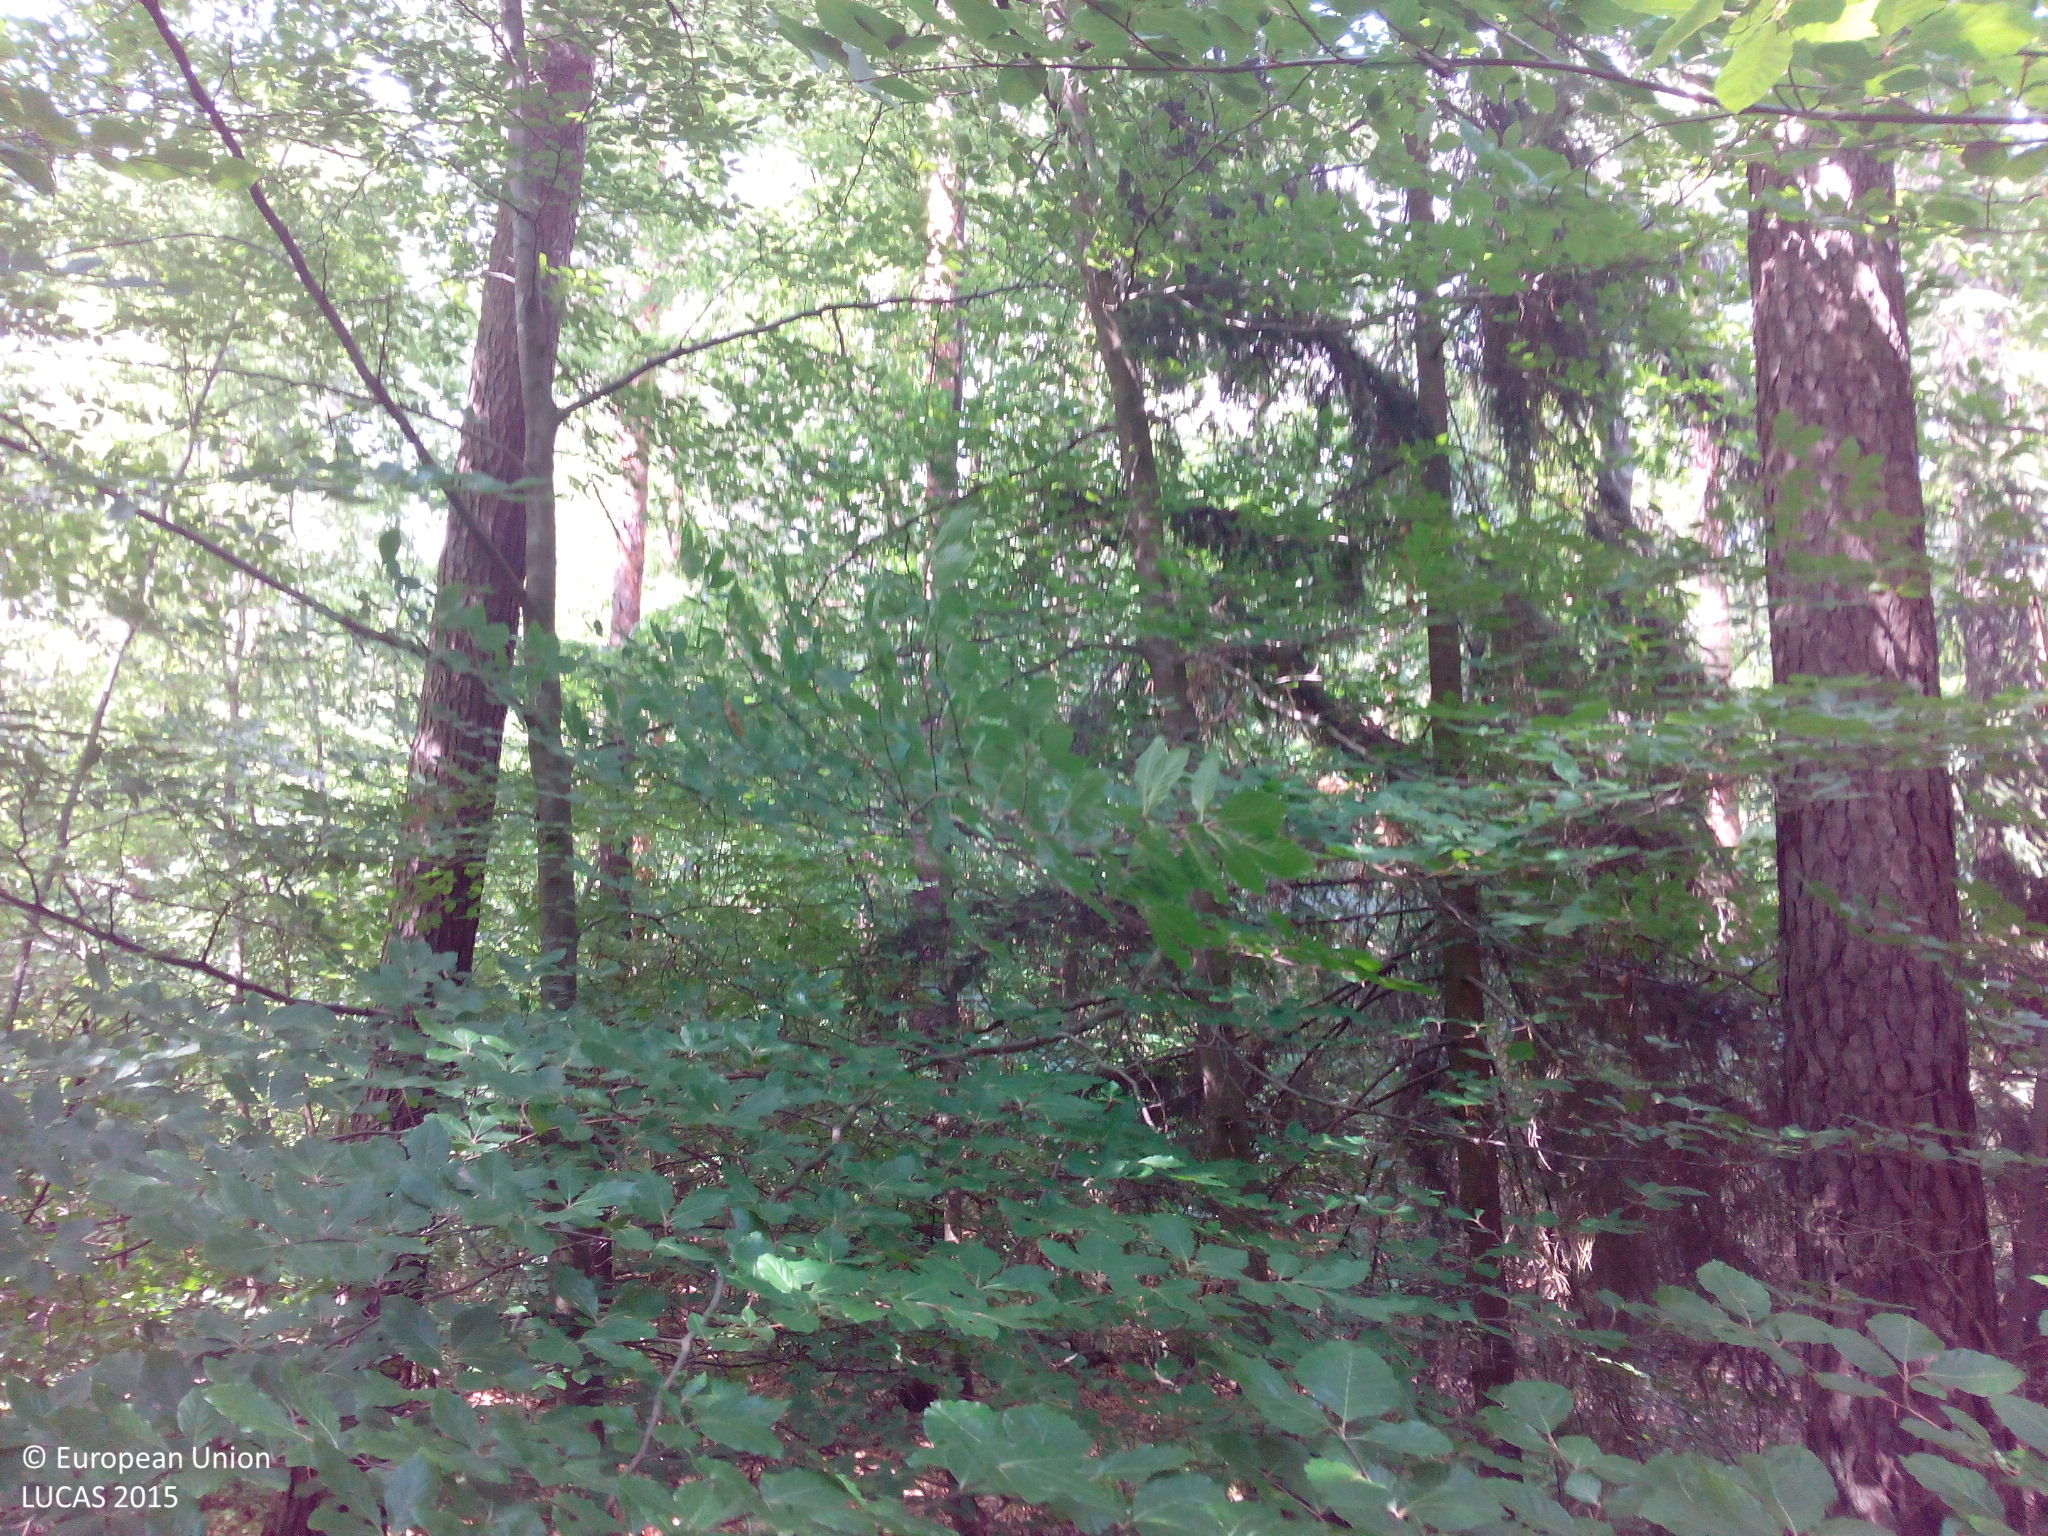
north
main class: Woodland
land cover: Pine dominated mixed woodland
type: hemiboreal forest and nemoral coniferous forest and mixed broadleaved-coniferous forest
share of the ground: > 75 %
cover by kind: broadleaved forest trees 70 %, coniferous forest trees 25 %, unconsolidated bare surface 5 %
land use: Forestry
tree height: > 5 m
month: June
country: DE
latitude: 49.5380
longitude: 8.0521
